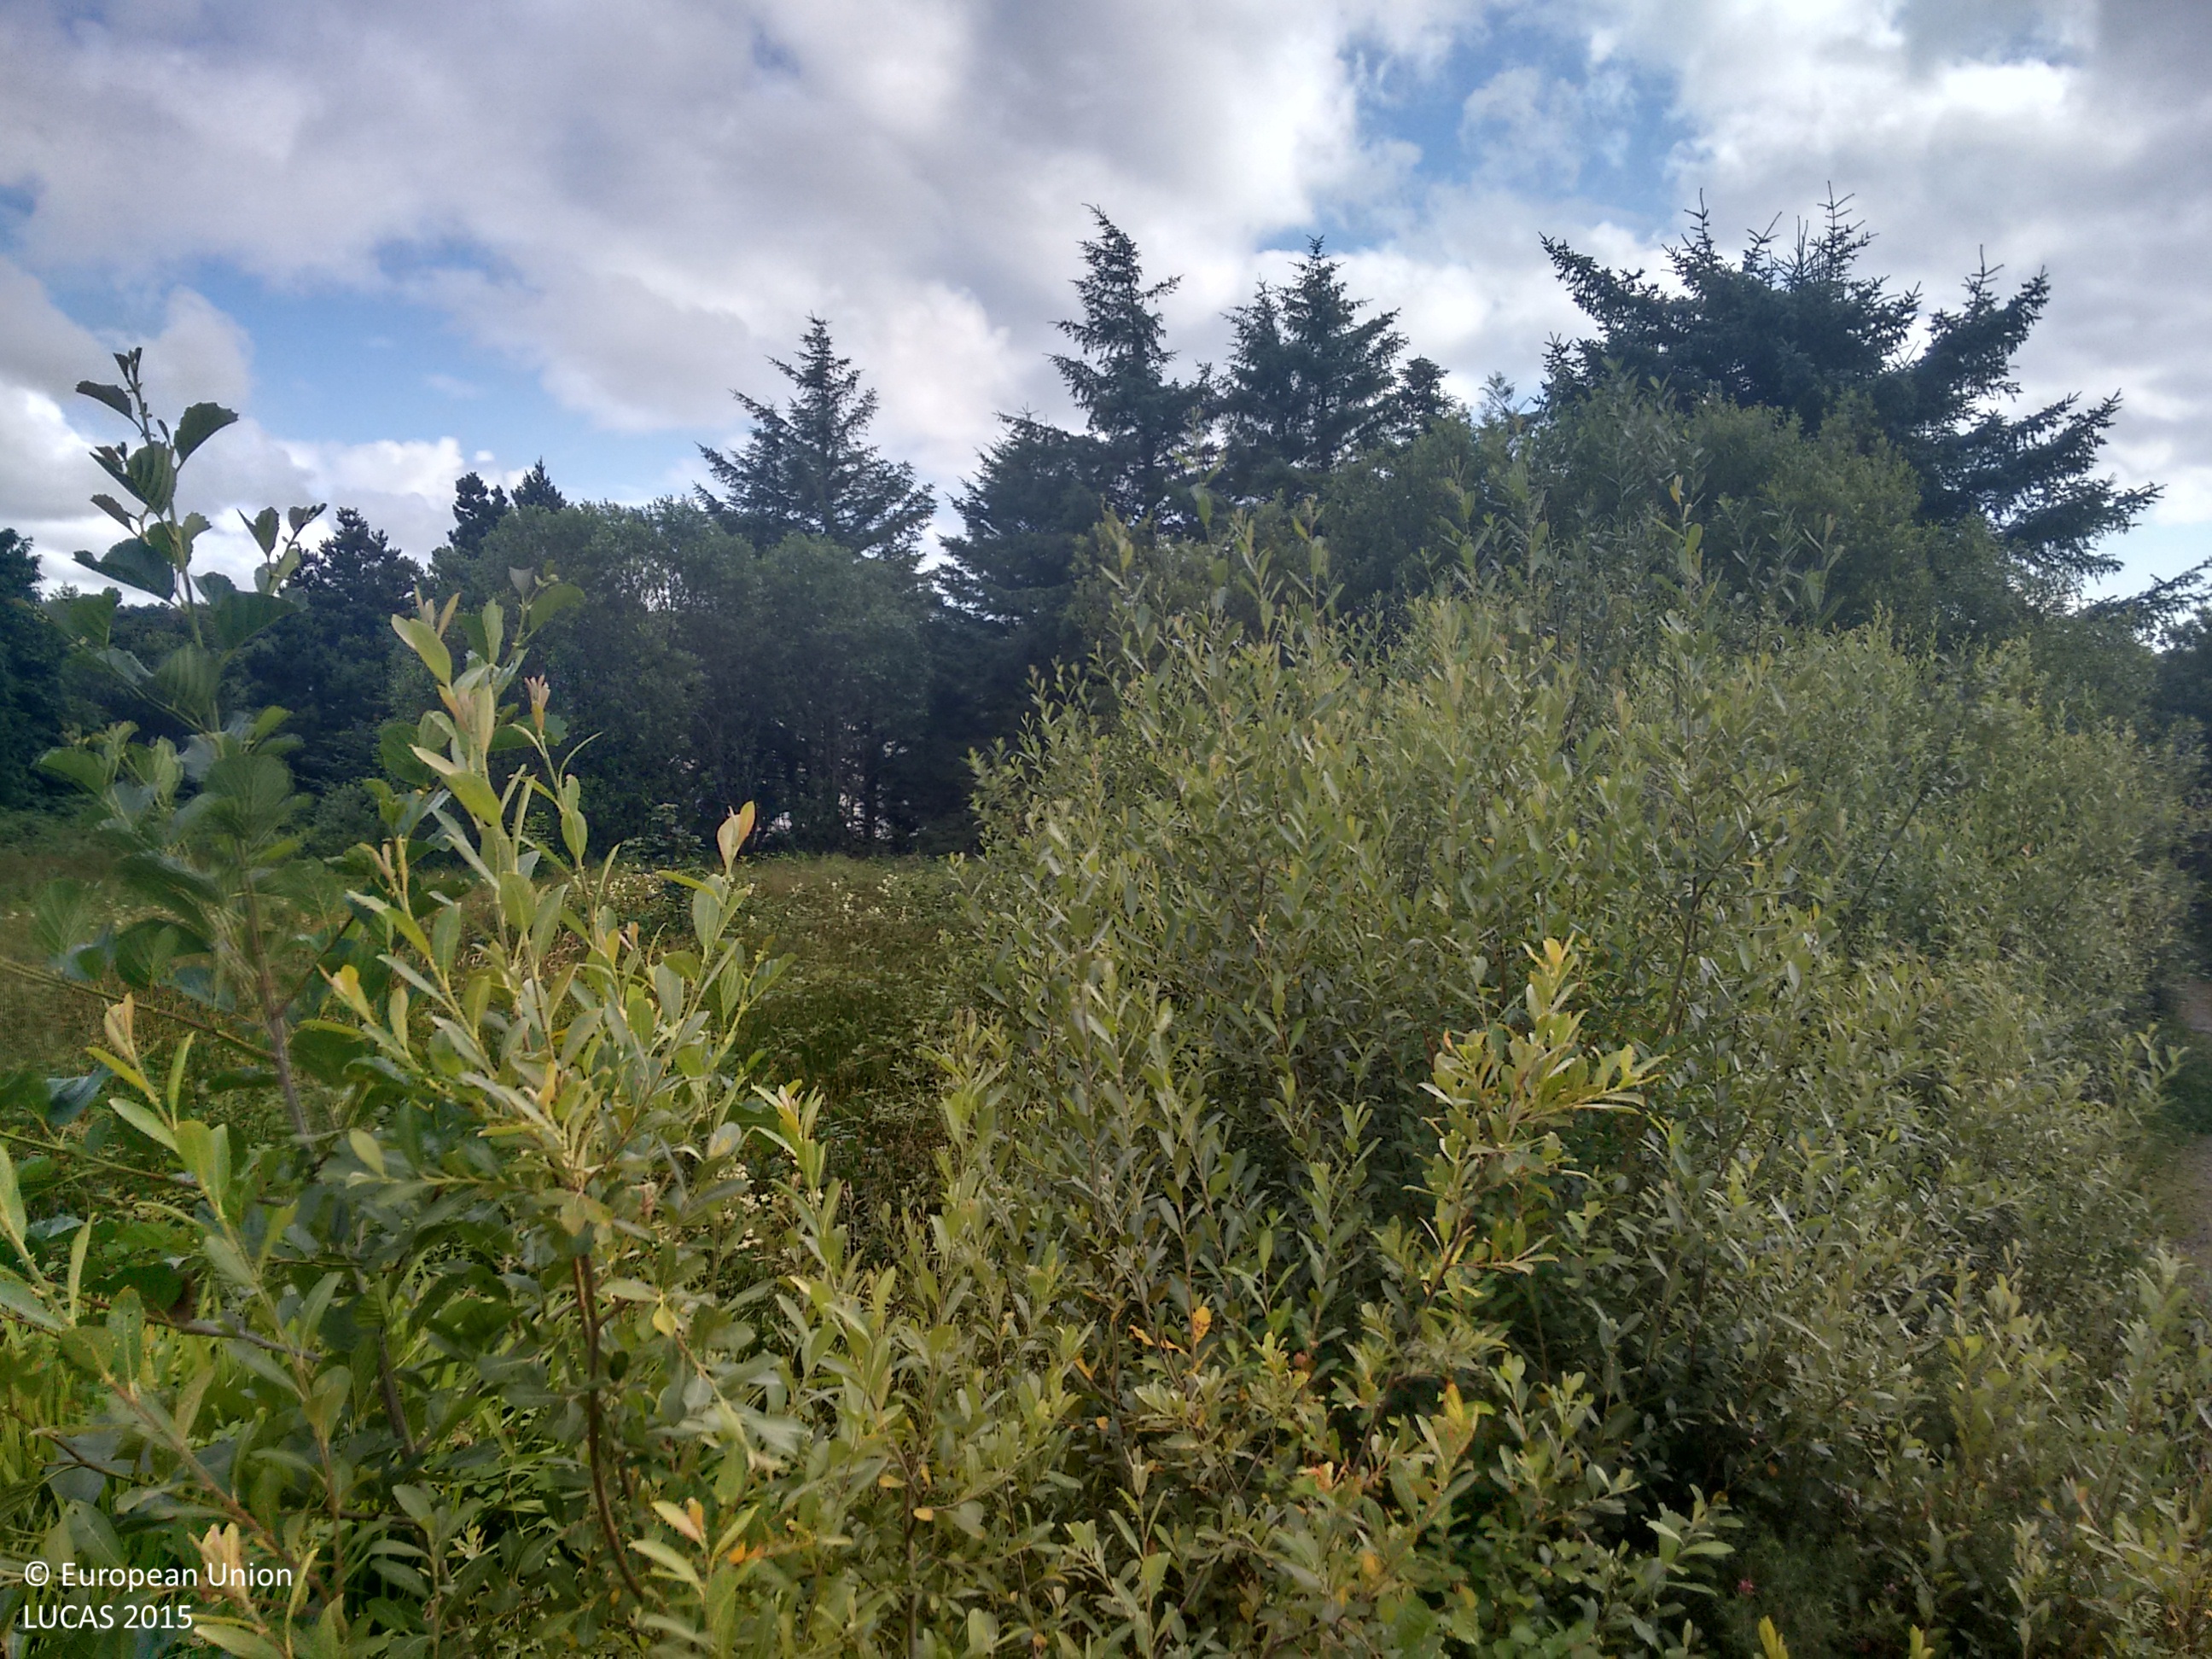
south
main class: Grassland
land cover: Grassland with sparse tree/shrub cover
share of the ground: > 75 %
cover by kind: herbaceous plants 85 %, shrubs 10 %, broadleaved forest trees 5 %
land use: Semi-natural and natural areas not in use
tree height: < 5 m
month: July
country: IE
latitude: 53.5539
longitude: -9.9500
